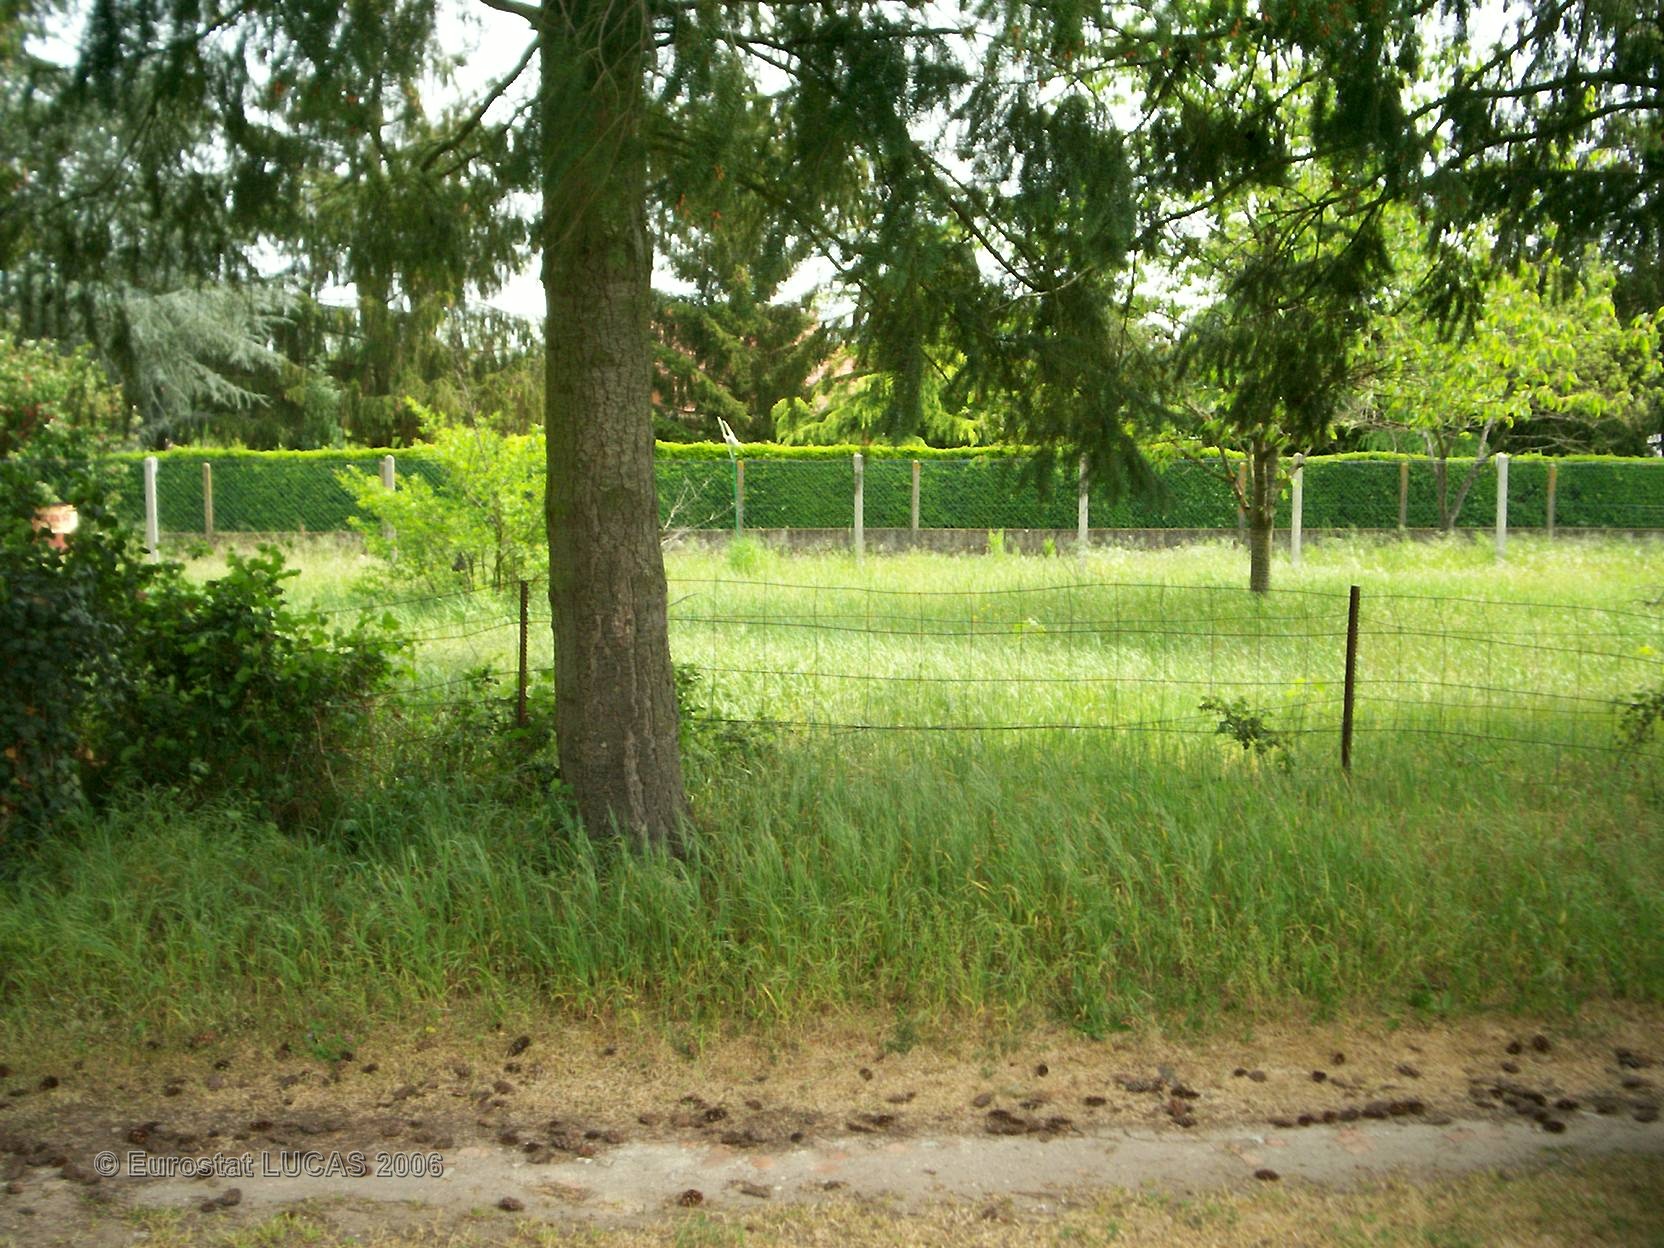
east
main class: Grassland
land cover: Grassland without tree/shrub cover
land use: Agriculture (excluding fallow land and kitchen gardens)
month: May
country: FR
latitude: 47.3156
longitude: 0.4139
